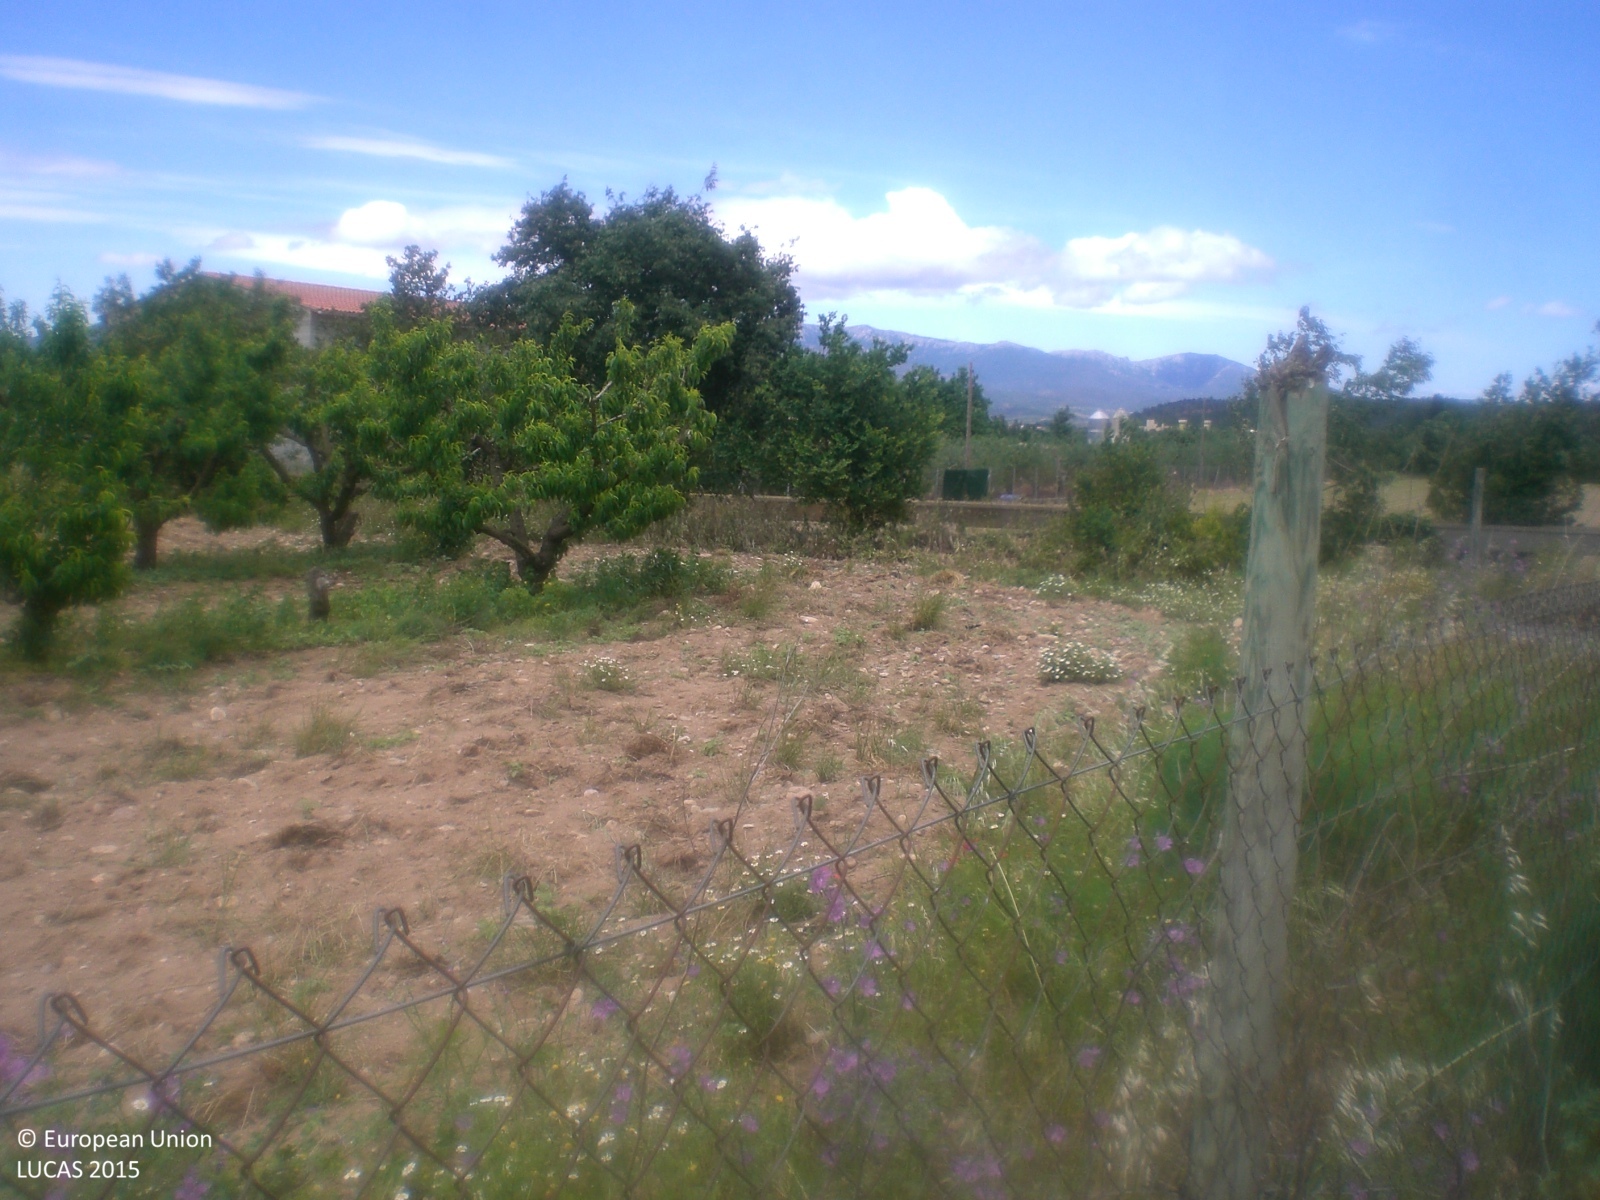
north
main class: Cropland
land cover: Other fruit trees and berries
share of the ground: 25 - 50 %
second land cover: Spontaneously vegetated surfaces
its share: 50 - 75 %
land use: Agriculture (excluding fallow land and kitchen gardens)
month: May
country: ES
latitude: 42.3186
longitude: 2.9644
